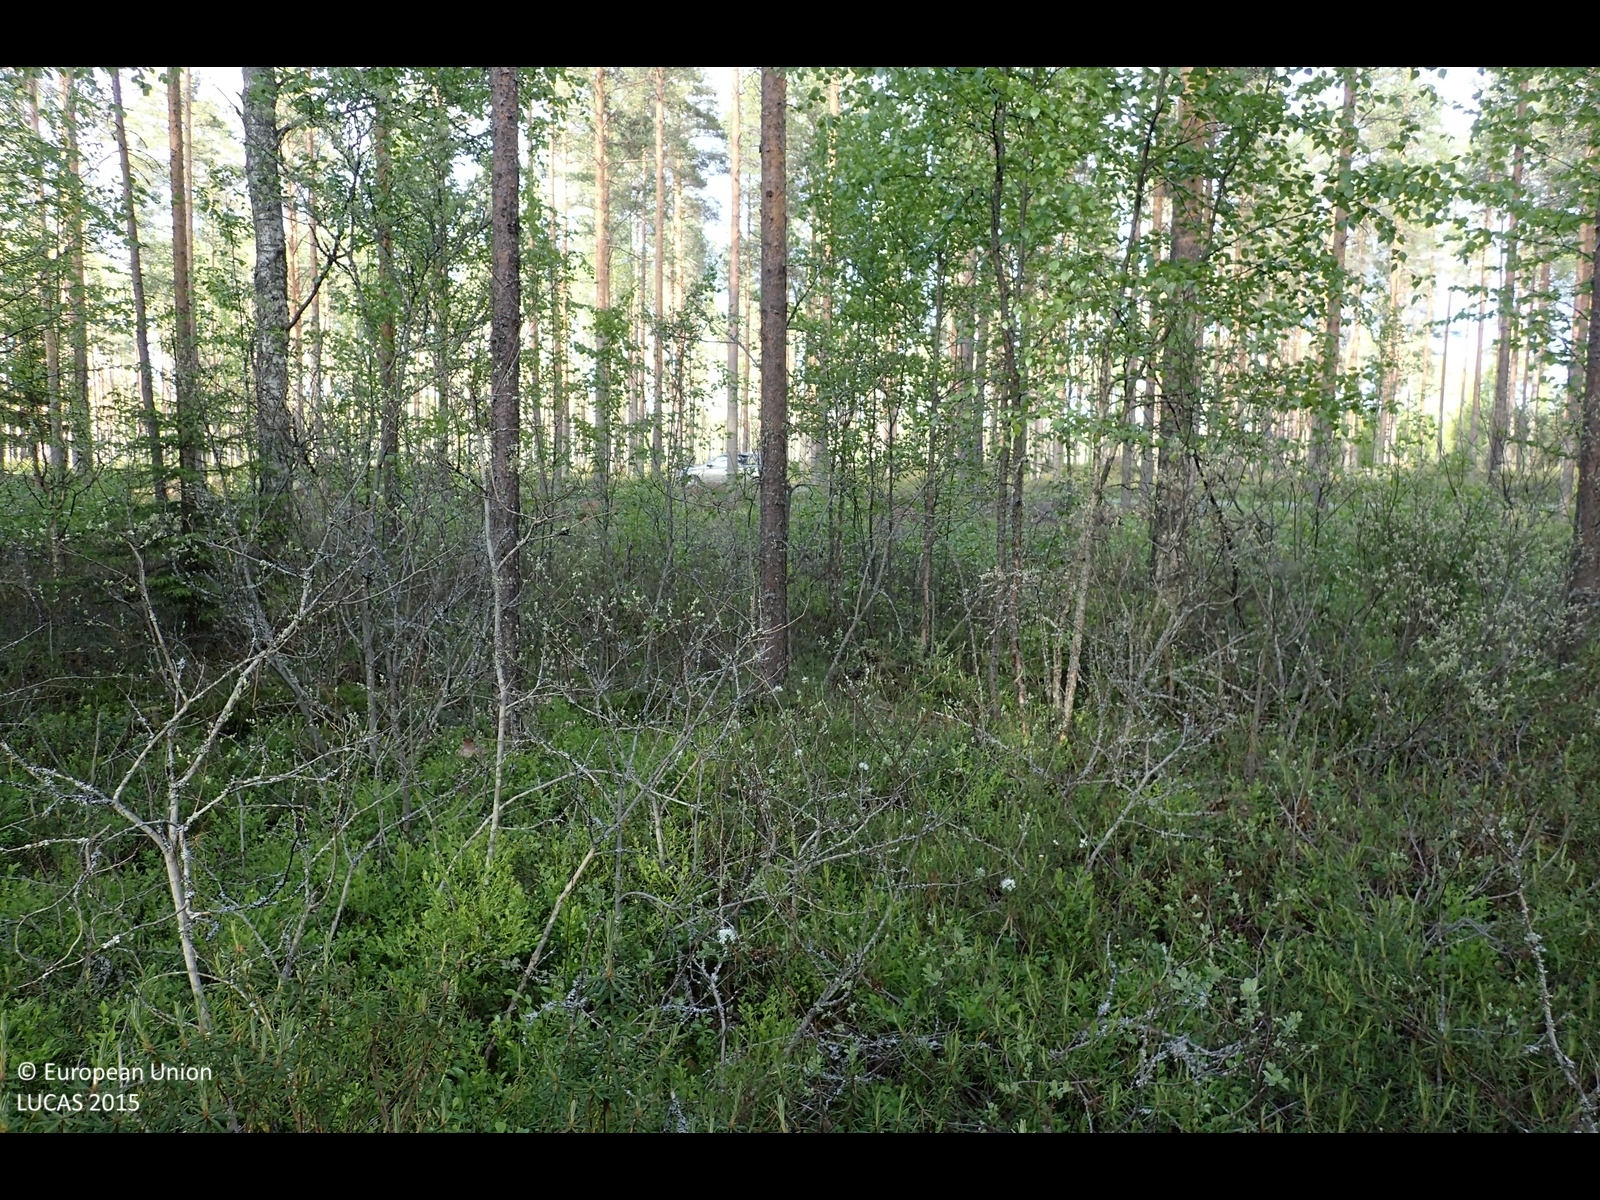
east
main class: Woodland
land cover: Pine dominated coniferous woodland
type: boreal forest
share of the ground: 25 - 50 %
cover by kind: shrubs 55 %, coniferous forest trees 40 %, broadleaved forest trees 5 %
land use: Forestry
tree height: > 5 m
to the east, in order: Pine dominated coniferous woodland; Ditches and canals; Grass margins; Paved roads, cycling and walking lanes; Grass margins; Ditches and canals; Pine dominated coniferous woodland; Tracks; Pine dominated coniferous woodland; Tracks; Pine dominated coniferous woodland; Tracks; Pine dominated coniferous woodland; Tracks; Pine dominated coniferous woodland; Tracks; Pine dominated coniferous woodland; Paved roads, cycling and walking lanes; Pine dominated coniferous woodland; Tracks; Pine dominated coniferous woodland; Tracks; Pine dominated coniferous woodland; Tracks; Pine dominated coniferous woodland; Tracks; Broadleaved woodland; Spontaneously vegetated surfaces
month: June
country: FI
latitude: 62.4398
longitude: 23.1035
